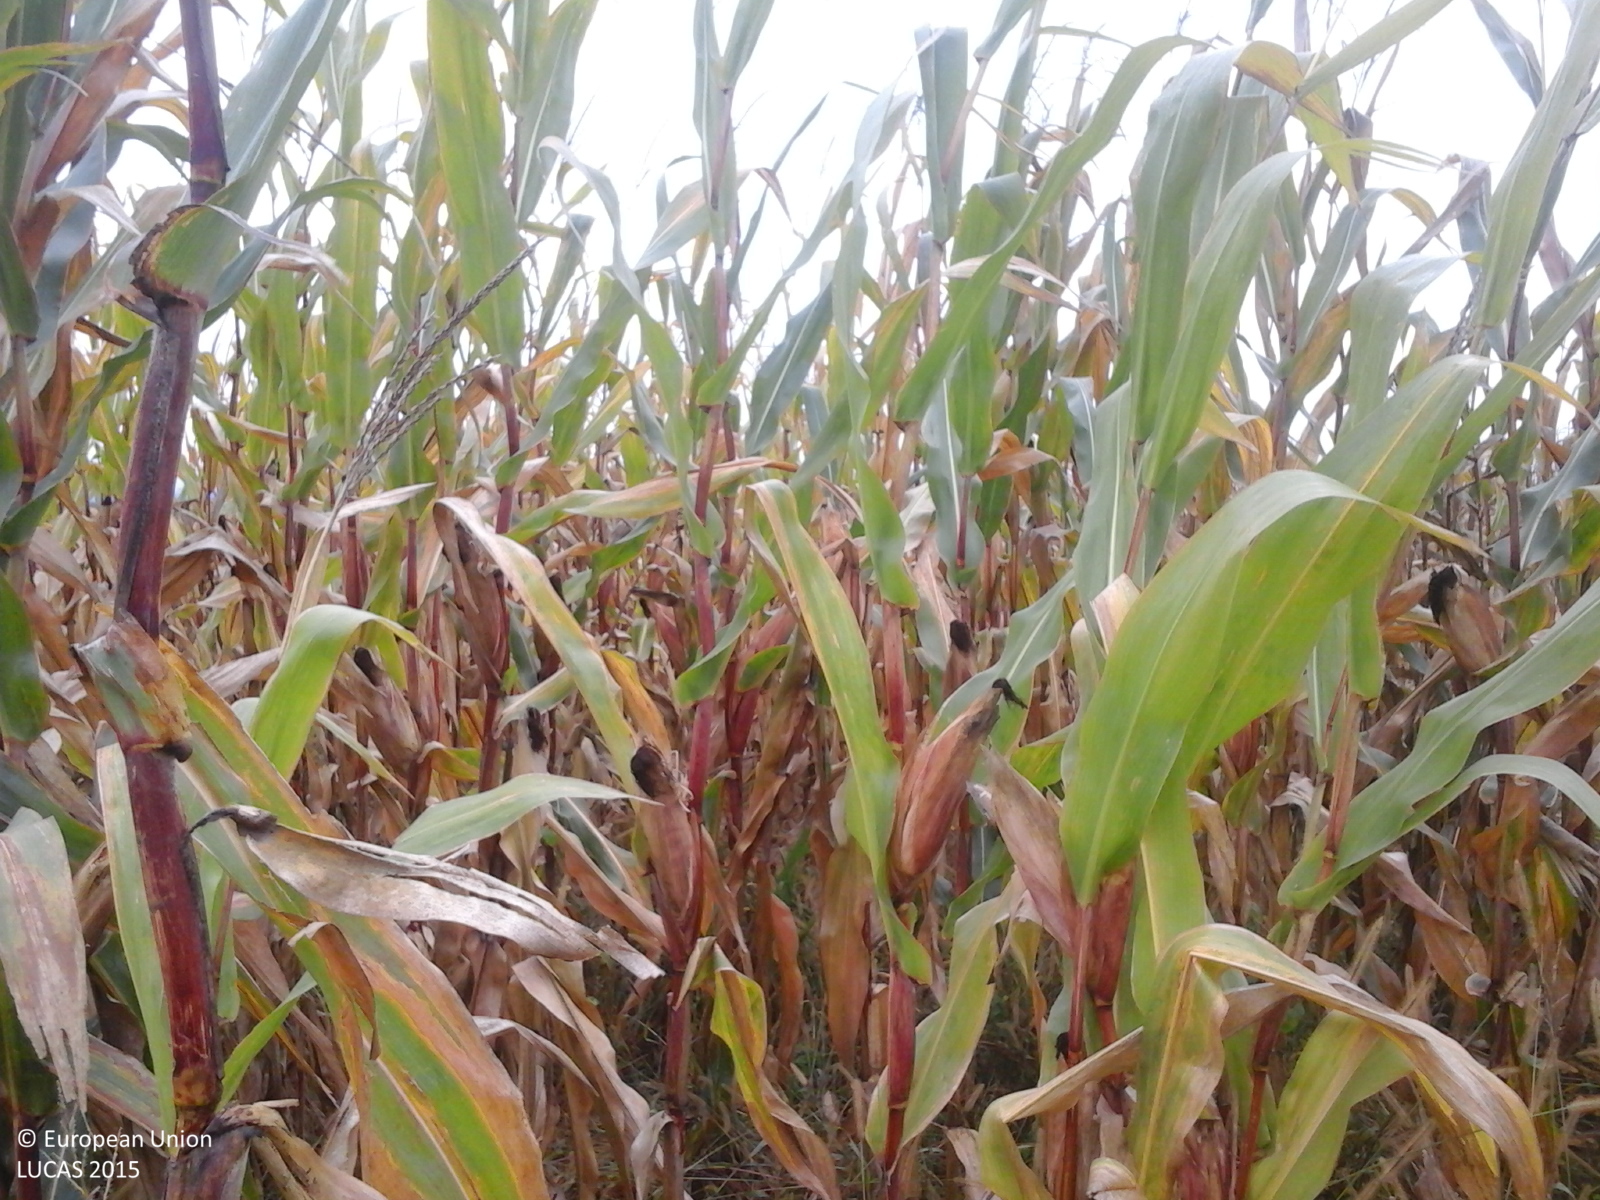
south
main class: Cropland
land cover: Maize
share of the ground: > 75 %
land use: Agriculture (excluding fallow land and kitchen gardens)
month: October
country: RO
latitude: 45.7882
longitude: 24.5541
